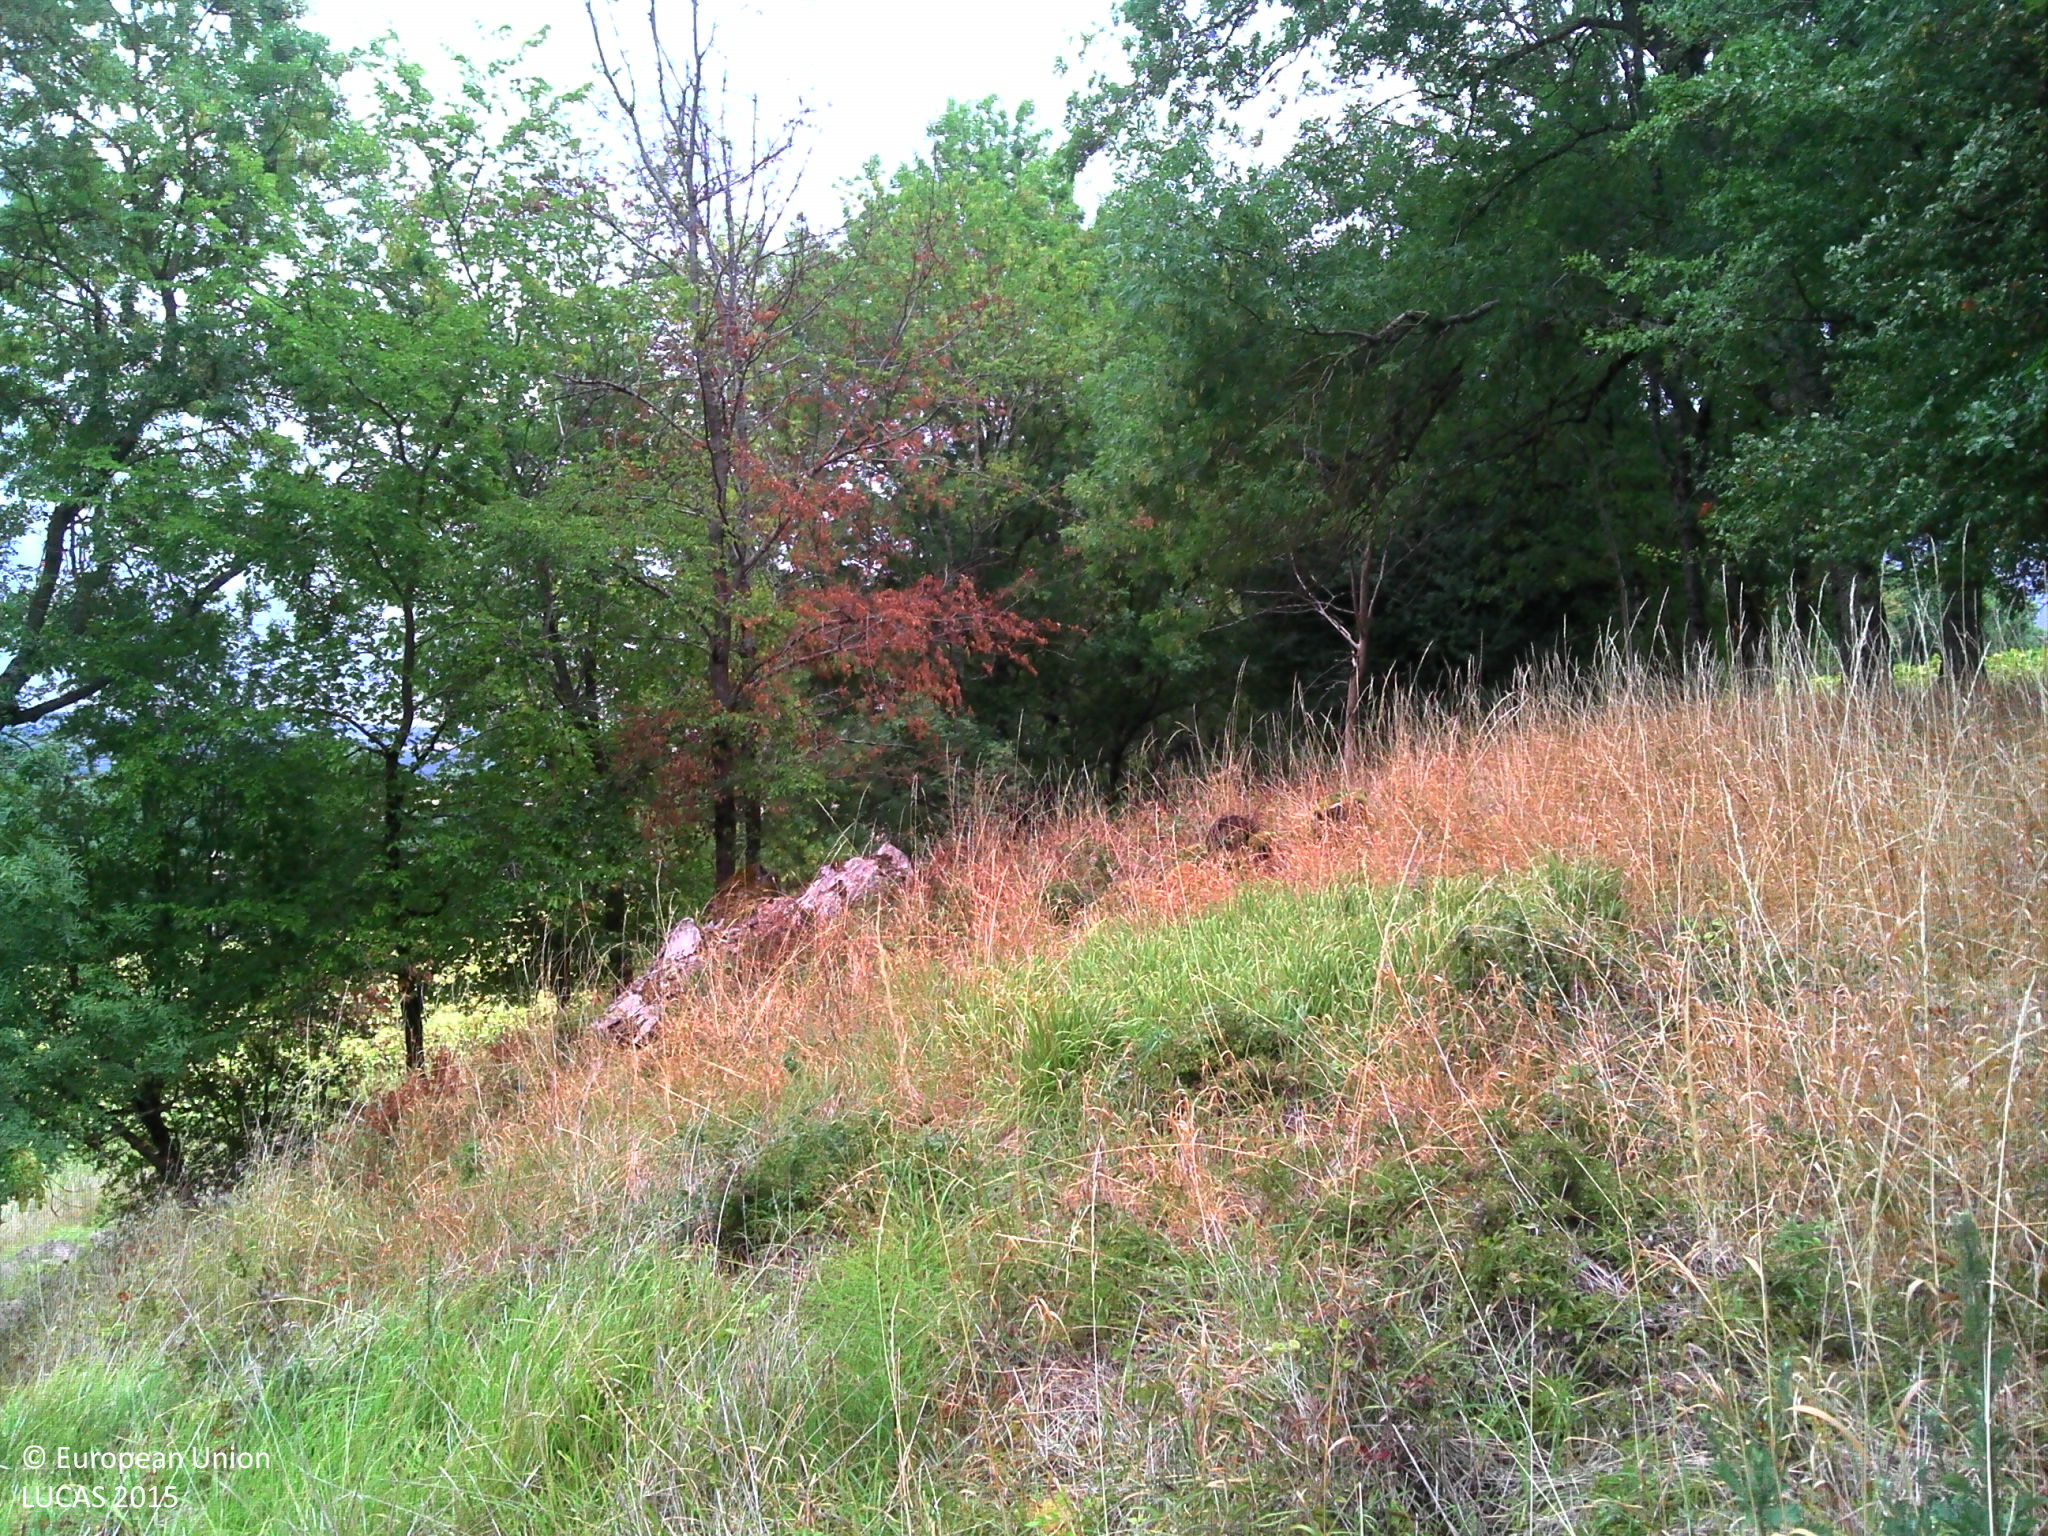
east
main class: Woodland
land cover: Broadleaved woodland
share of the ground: > 75 %
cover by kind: broadleaved forest trees 75 %, herbaceous plants 20 %, shrubs 5 %
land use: Semi-natural and natural areas not in use
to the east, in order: Broadleaved woodland; Grassland without tree/shrub cover; Sunflower; Sugar beet
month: August
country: FR
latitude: 44.2487
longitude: 0.5892
